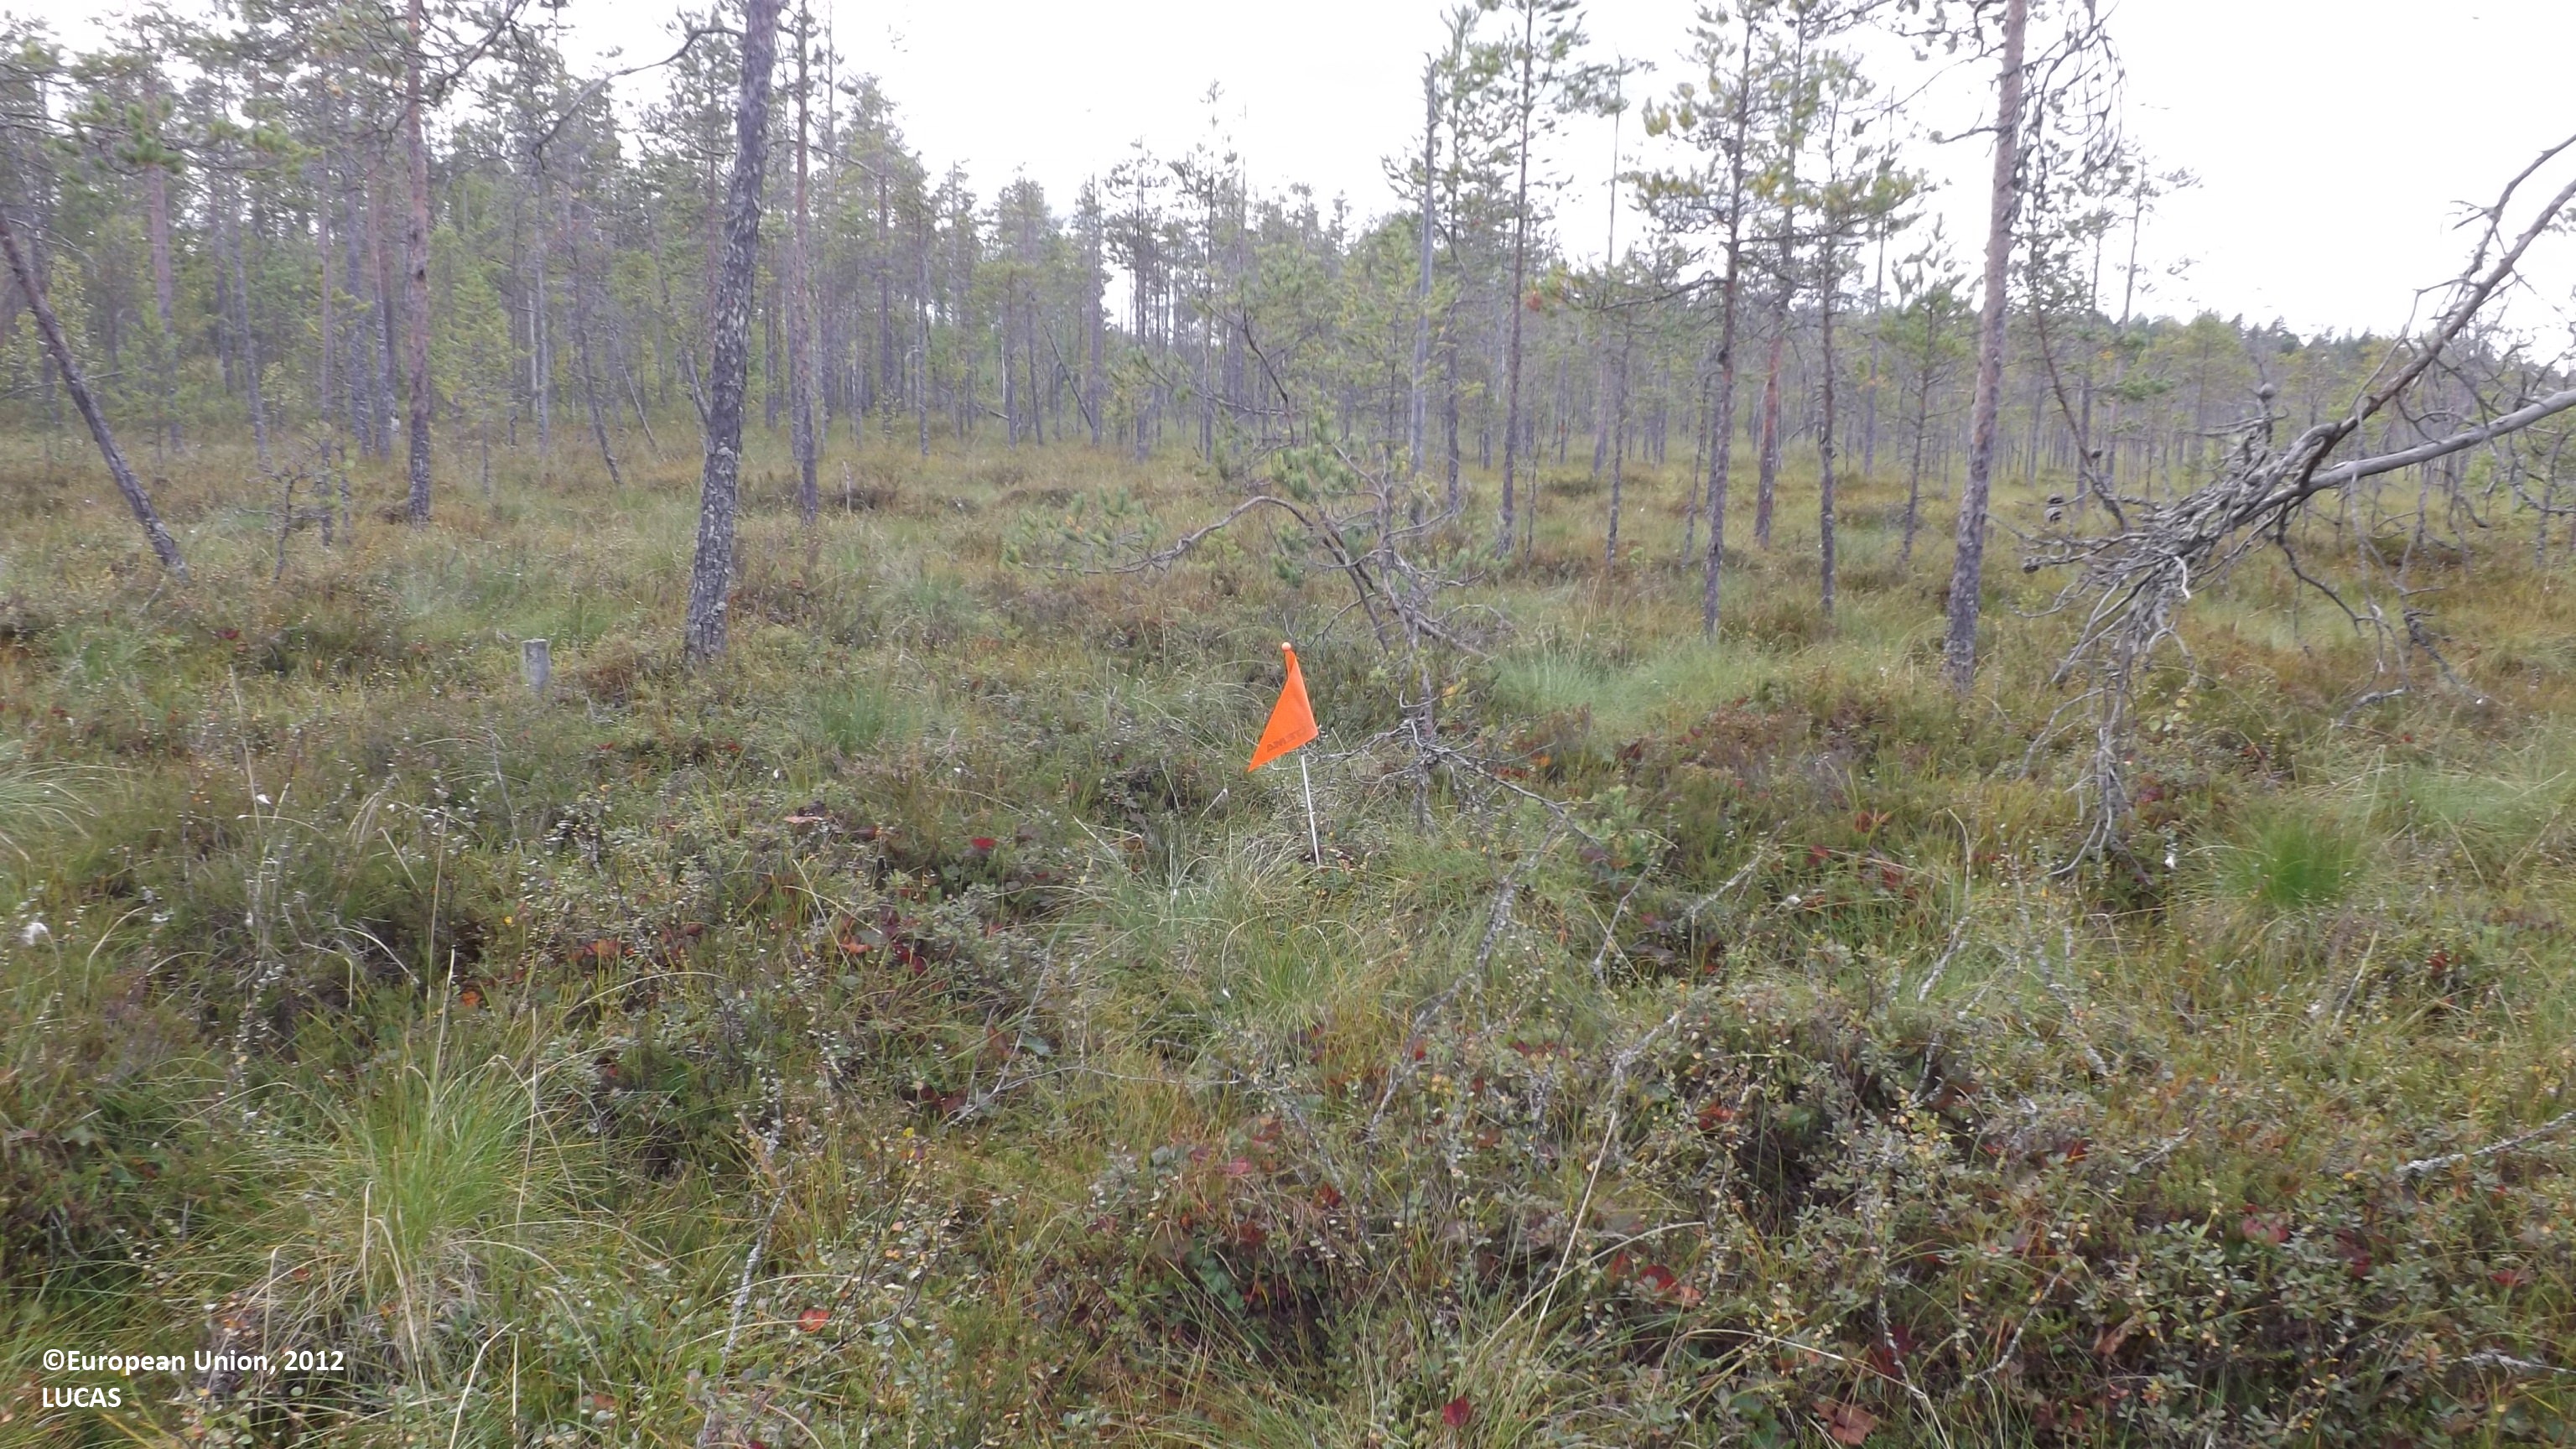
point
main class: Woodland
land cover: Pine dominated coniferous woodland
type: mire and swamp forests
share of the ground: 10 - 25 %
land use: Semi-natural and natural areas not in use
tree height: > 5 m
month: August
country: FI
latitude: 63.7839
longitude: 24.0892
